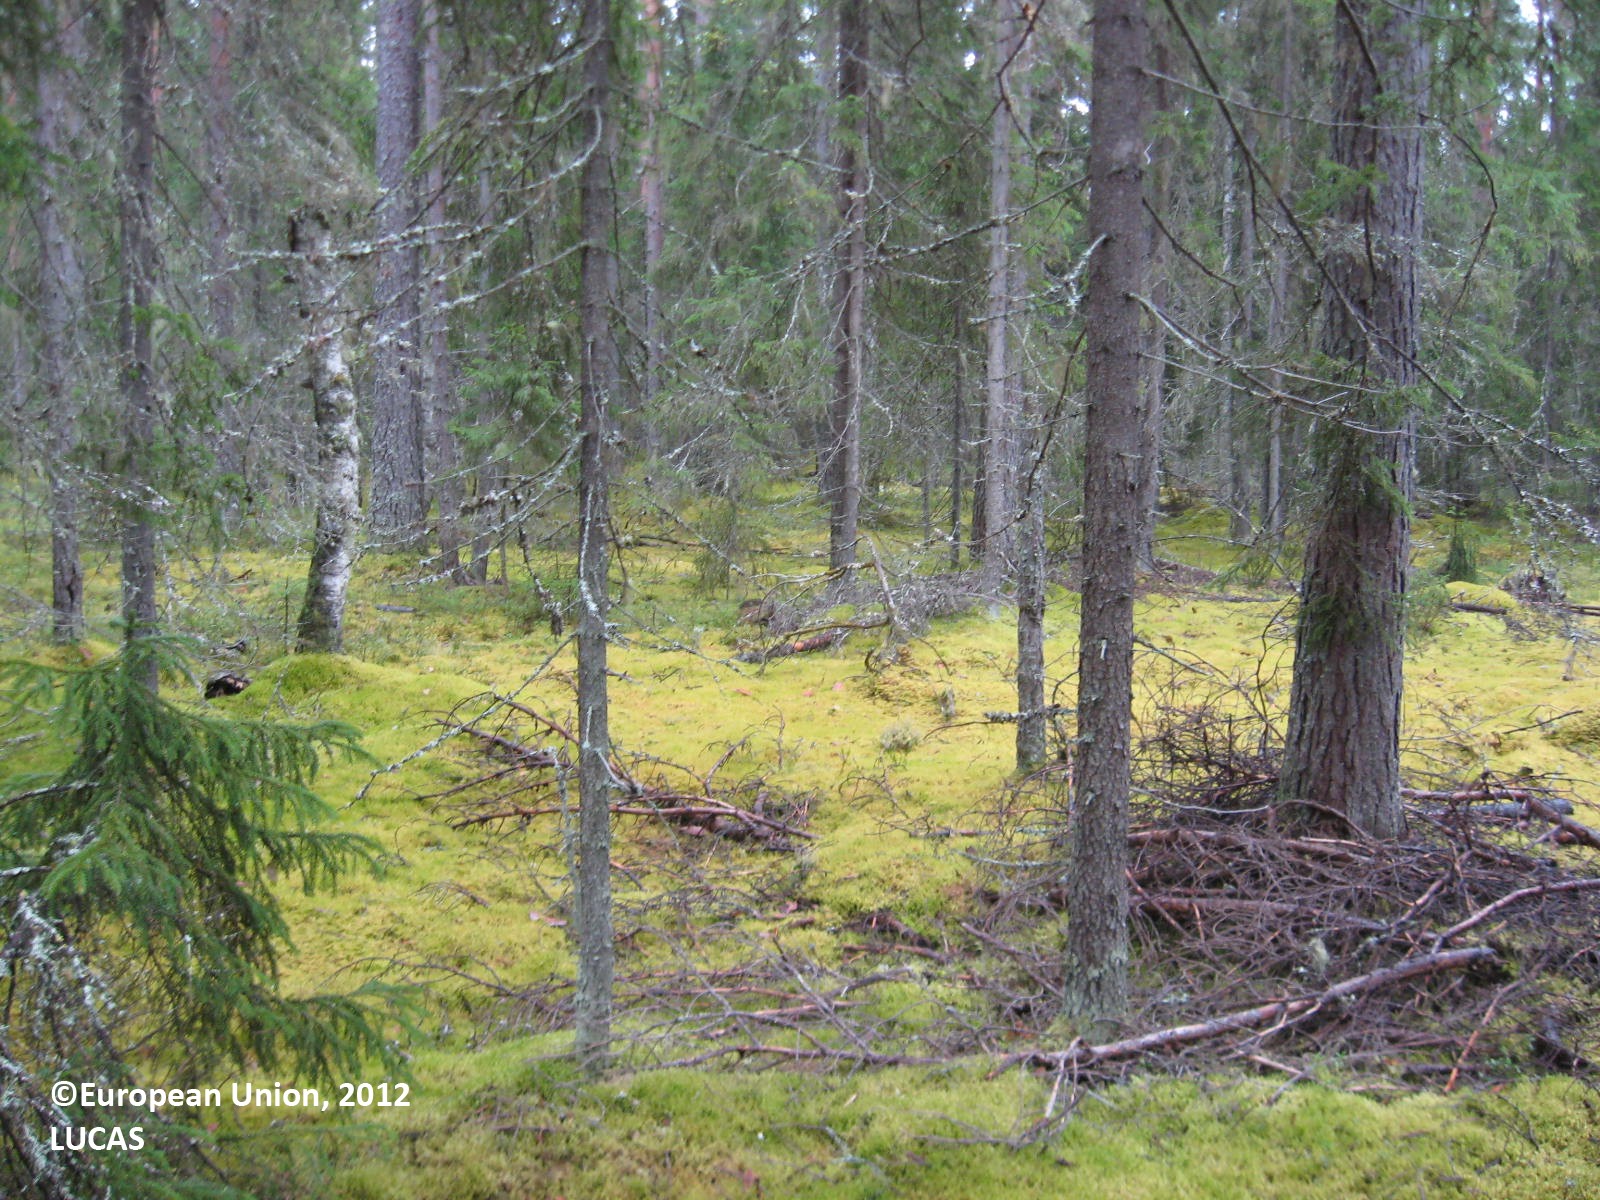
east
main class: Woodland
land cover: Other coniferous woodland
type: boreal forest
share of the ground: > 75 %
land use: Forestry
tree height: > 5 m
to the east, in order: Other coniferous woodland; Ditches and canals; Paved roads, cycling and walking lanes; Ditches and canals; Shruby margins; Electric lines; Other mixed woodland; Other coniferous woodland; Grassland without tree/shrub cover; Other mixed woodland
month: August
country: FI
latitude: 63.4906
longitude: 29.6101
